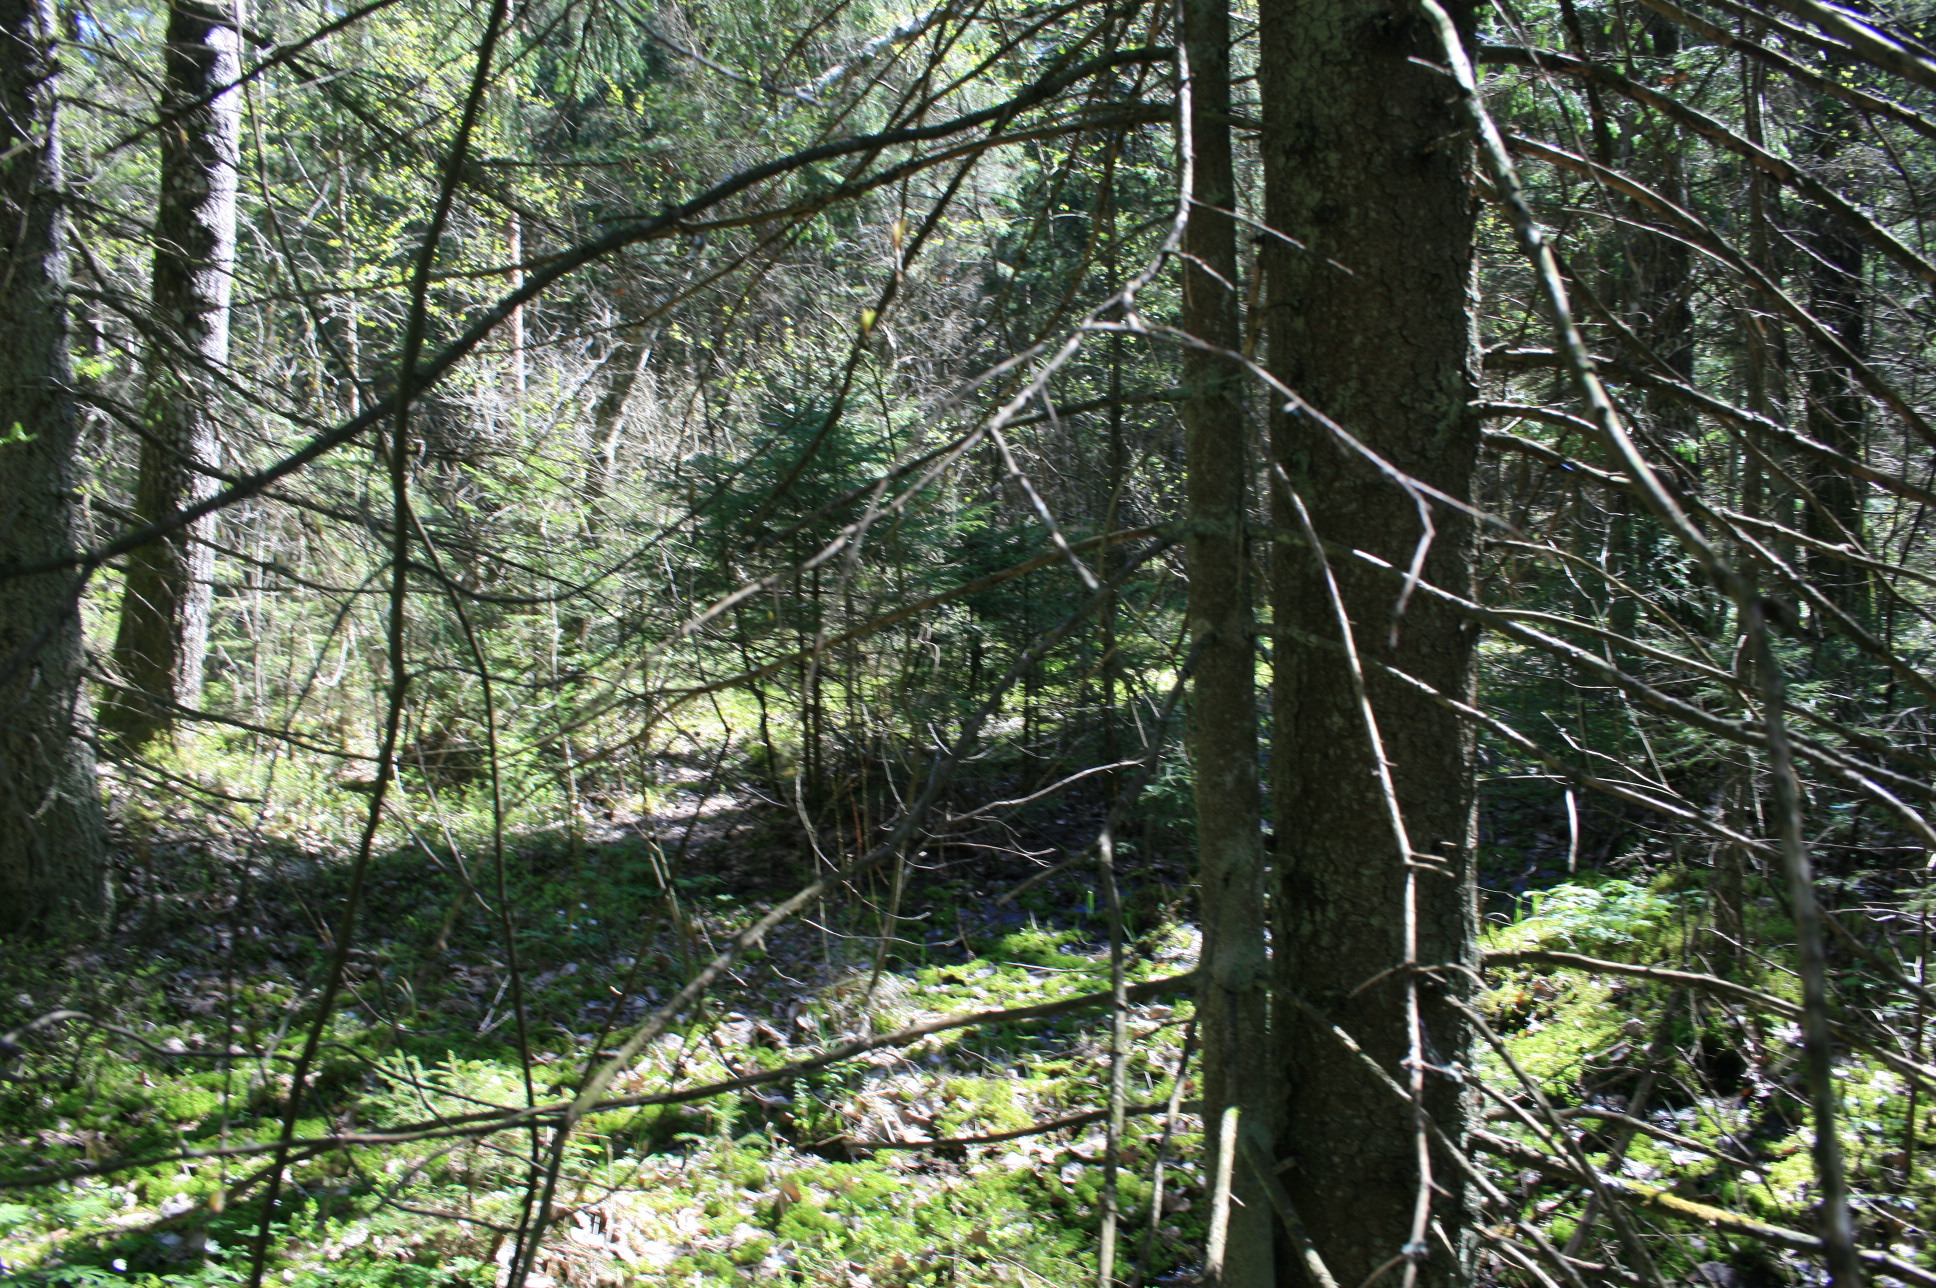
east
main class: Woodland
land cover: Other mixed woodland
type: hemiboreal forest and nemoral coniferous forest and mixed broadleaved-coniferous forest
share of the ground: > 75 %
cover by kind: coniferous forest trees 65 %, broadleaved forest trees 35 %
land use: Forestry
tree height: > 5 m
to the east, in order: Other mixed woodland; Other coniferous woodland; Spruce dominated mixed woodland; Other mixed woodland
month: May
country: LT
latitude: 56.0365
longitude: 21.4548
